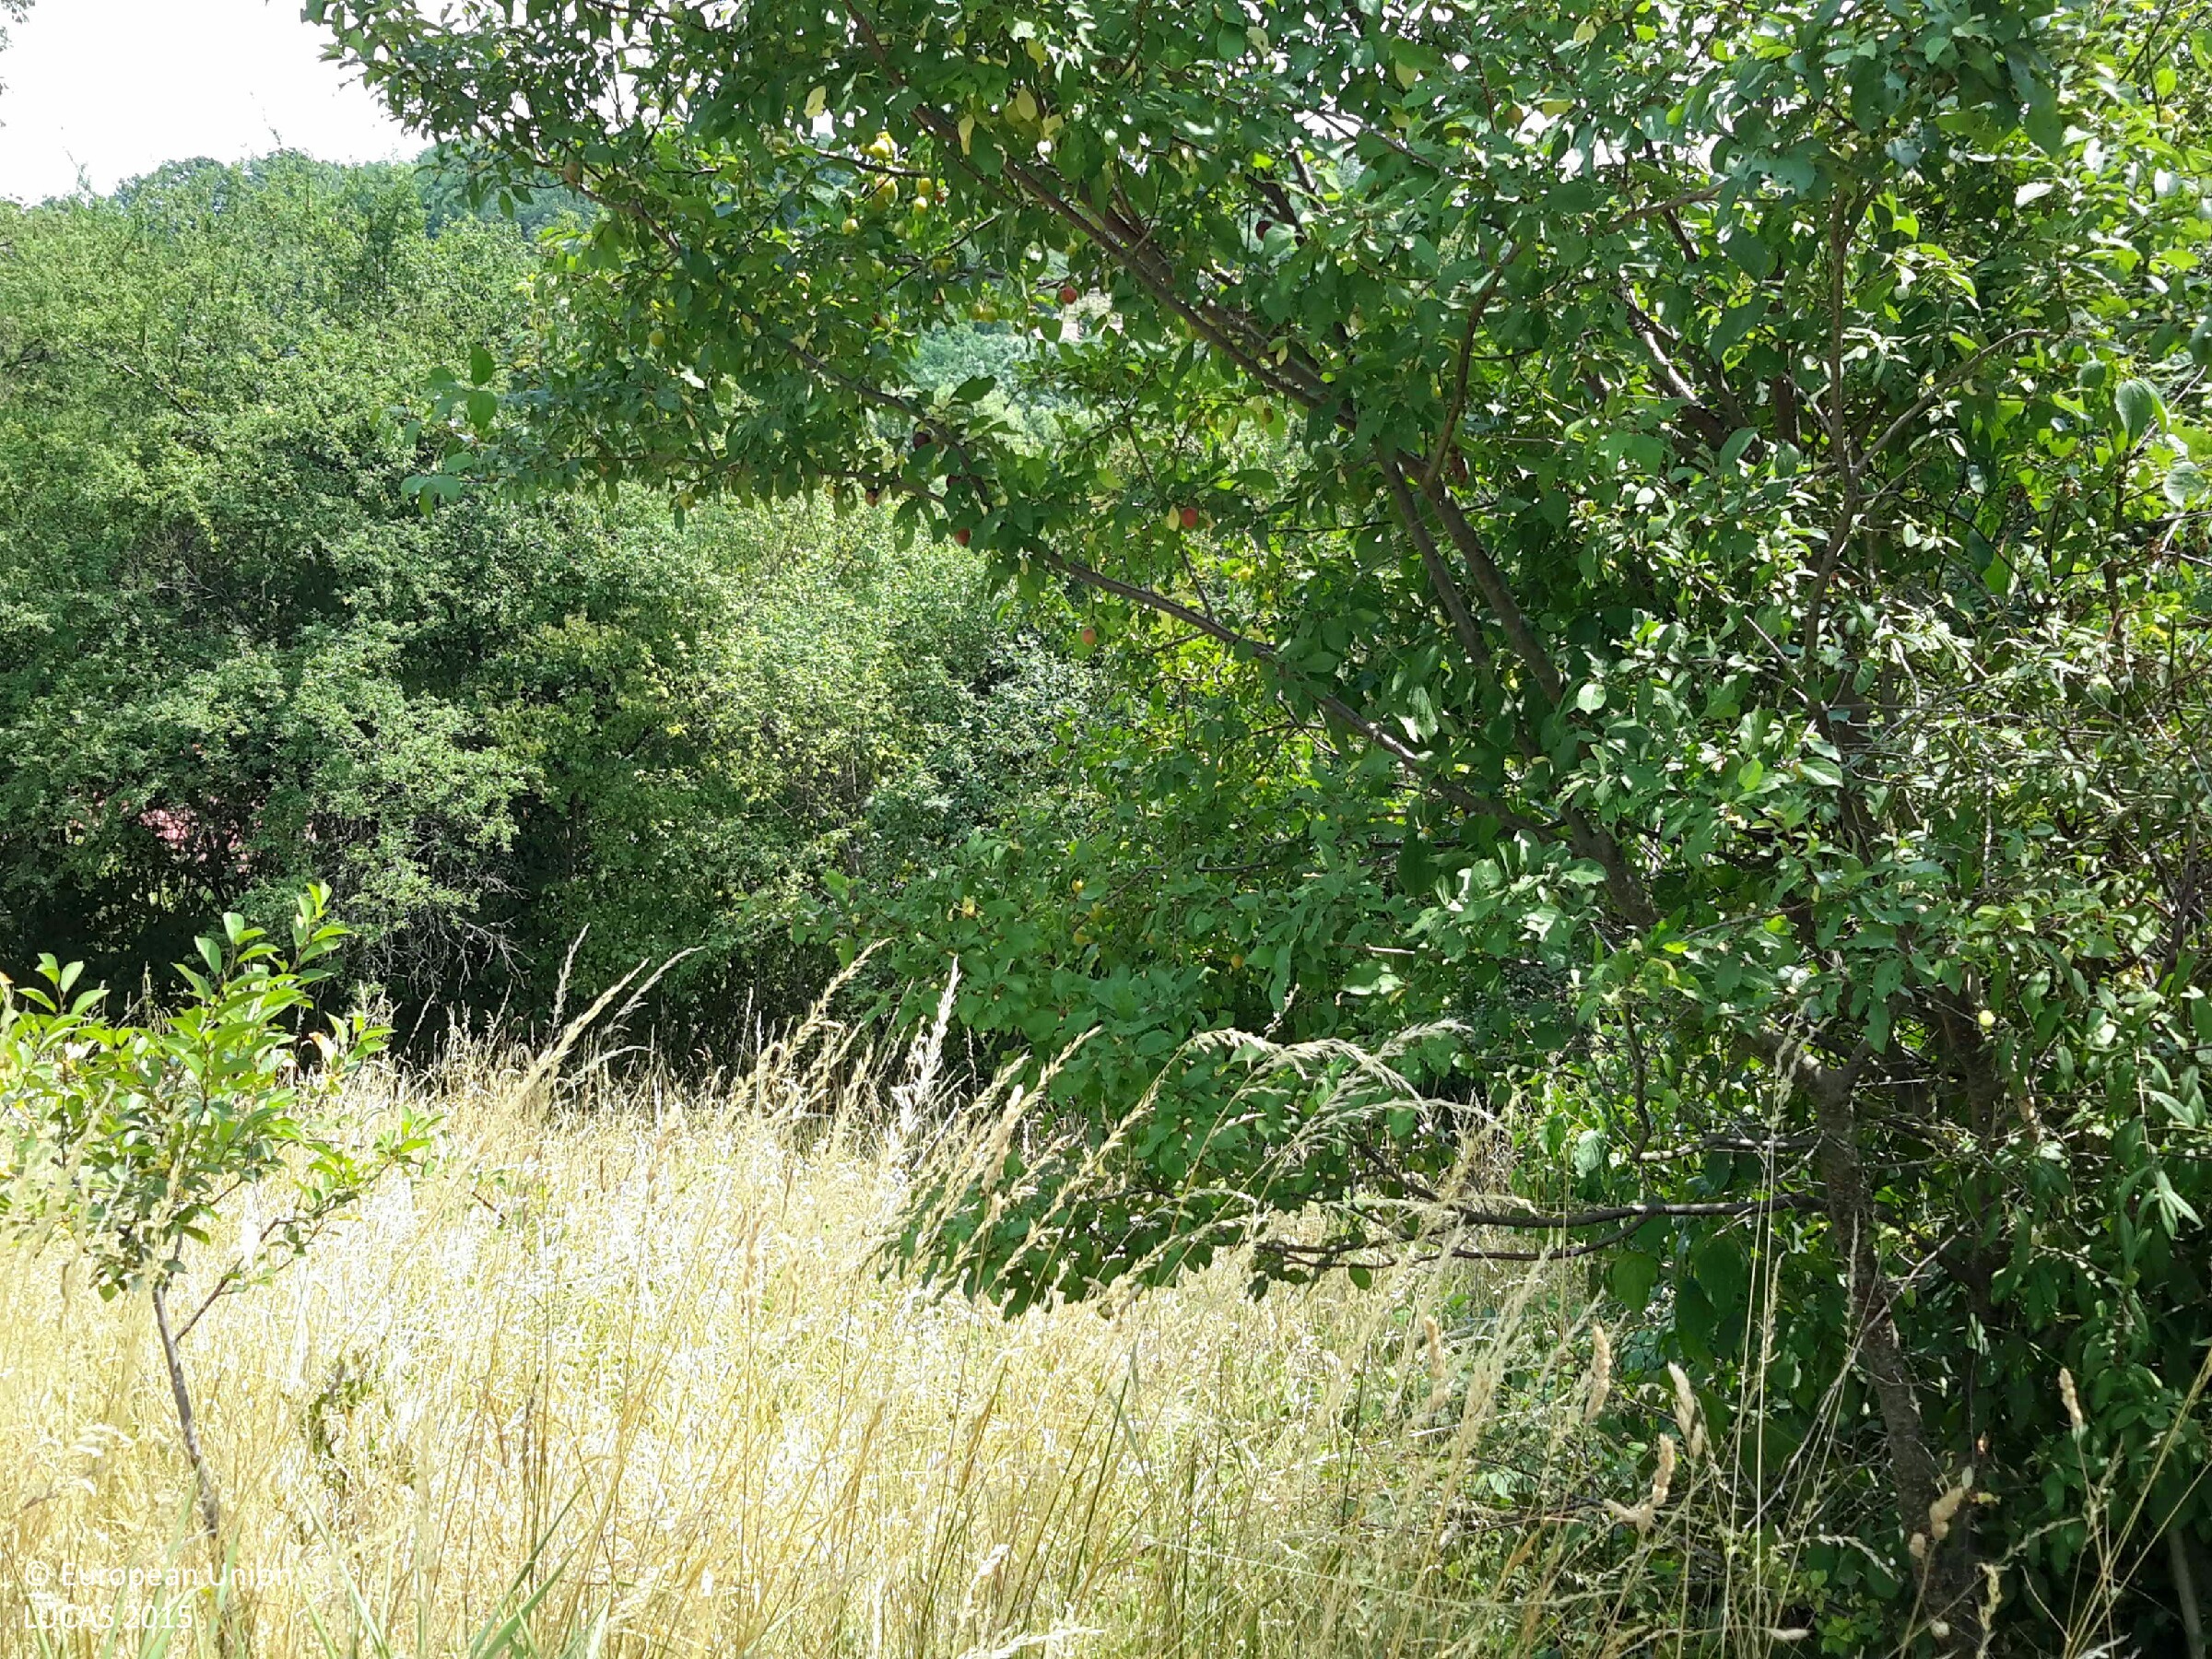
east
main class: Cropland
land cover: Other fruit trees and berries
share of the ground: 25 - 50 %
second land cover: Spontaneously vegetated surfaces
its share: 50 - 75 %
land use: Abandoned areas
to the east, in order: Other fruit trees and berries; Spontaneously vegetated surfaces; Electric lines; Broadleaved woodland; Fences; Grass margins; Paved roads, cycling and walking lanes; Grass margins; Electric lines; Grassland with sparse tree/shrub cover; Artificial constructions in urban areas; Broadleaved woodland; Spontaneously vegetated surfaces; Broadleaved woodland
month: July
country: HU
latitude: 47.6533
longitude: 16.4880
